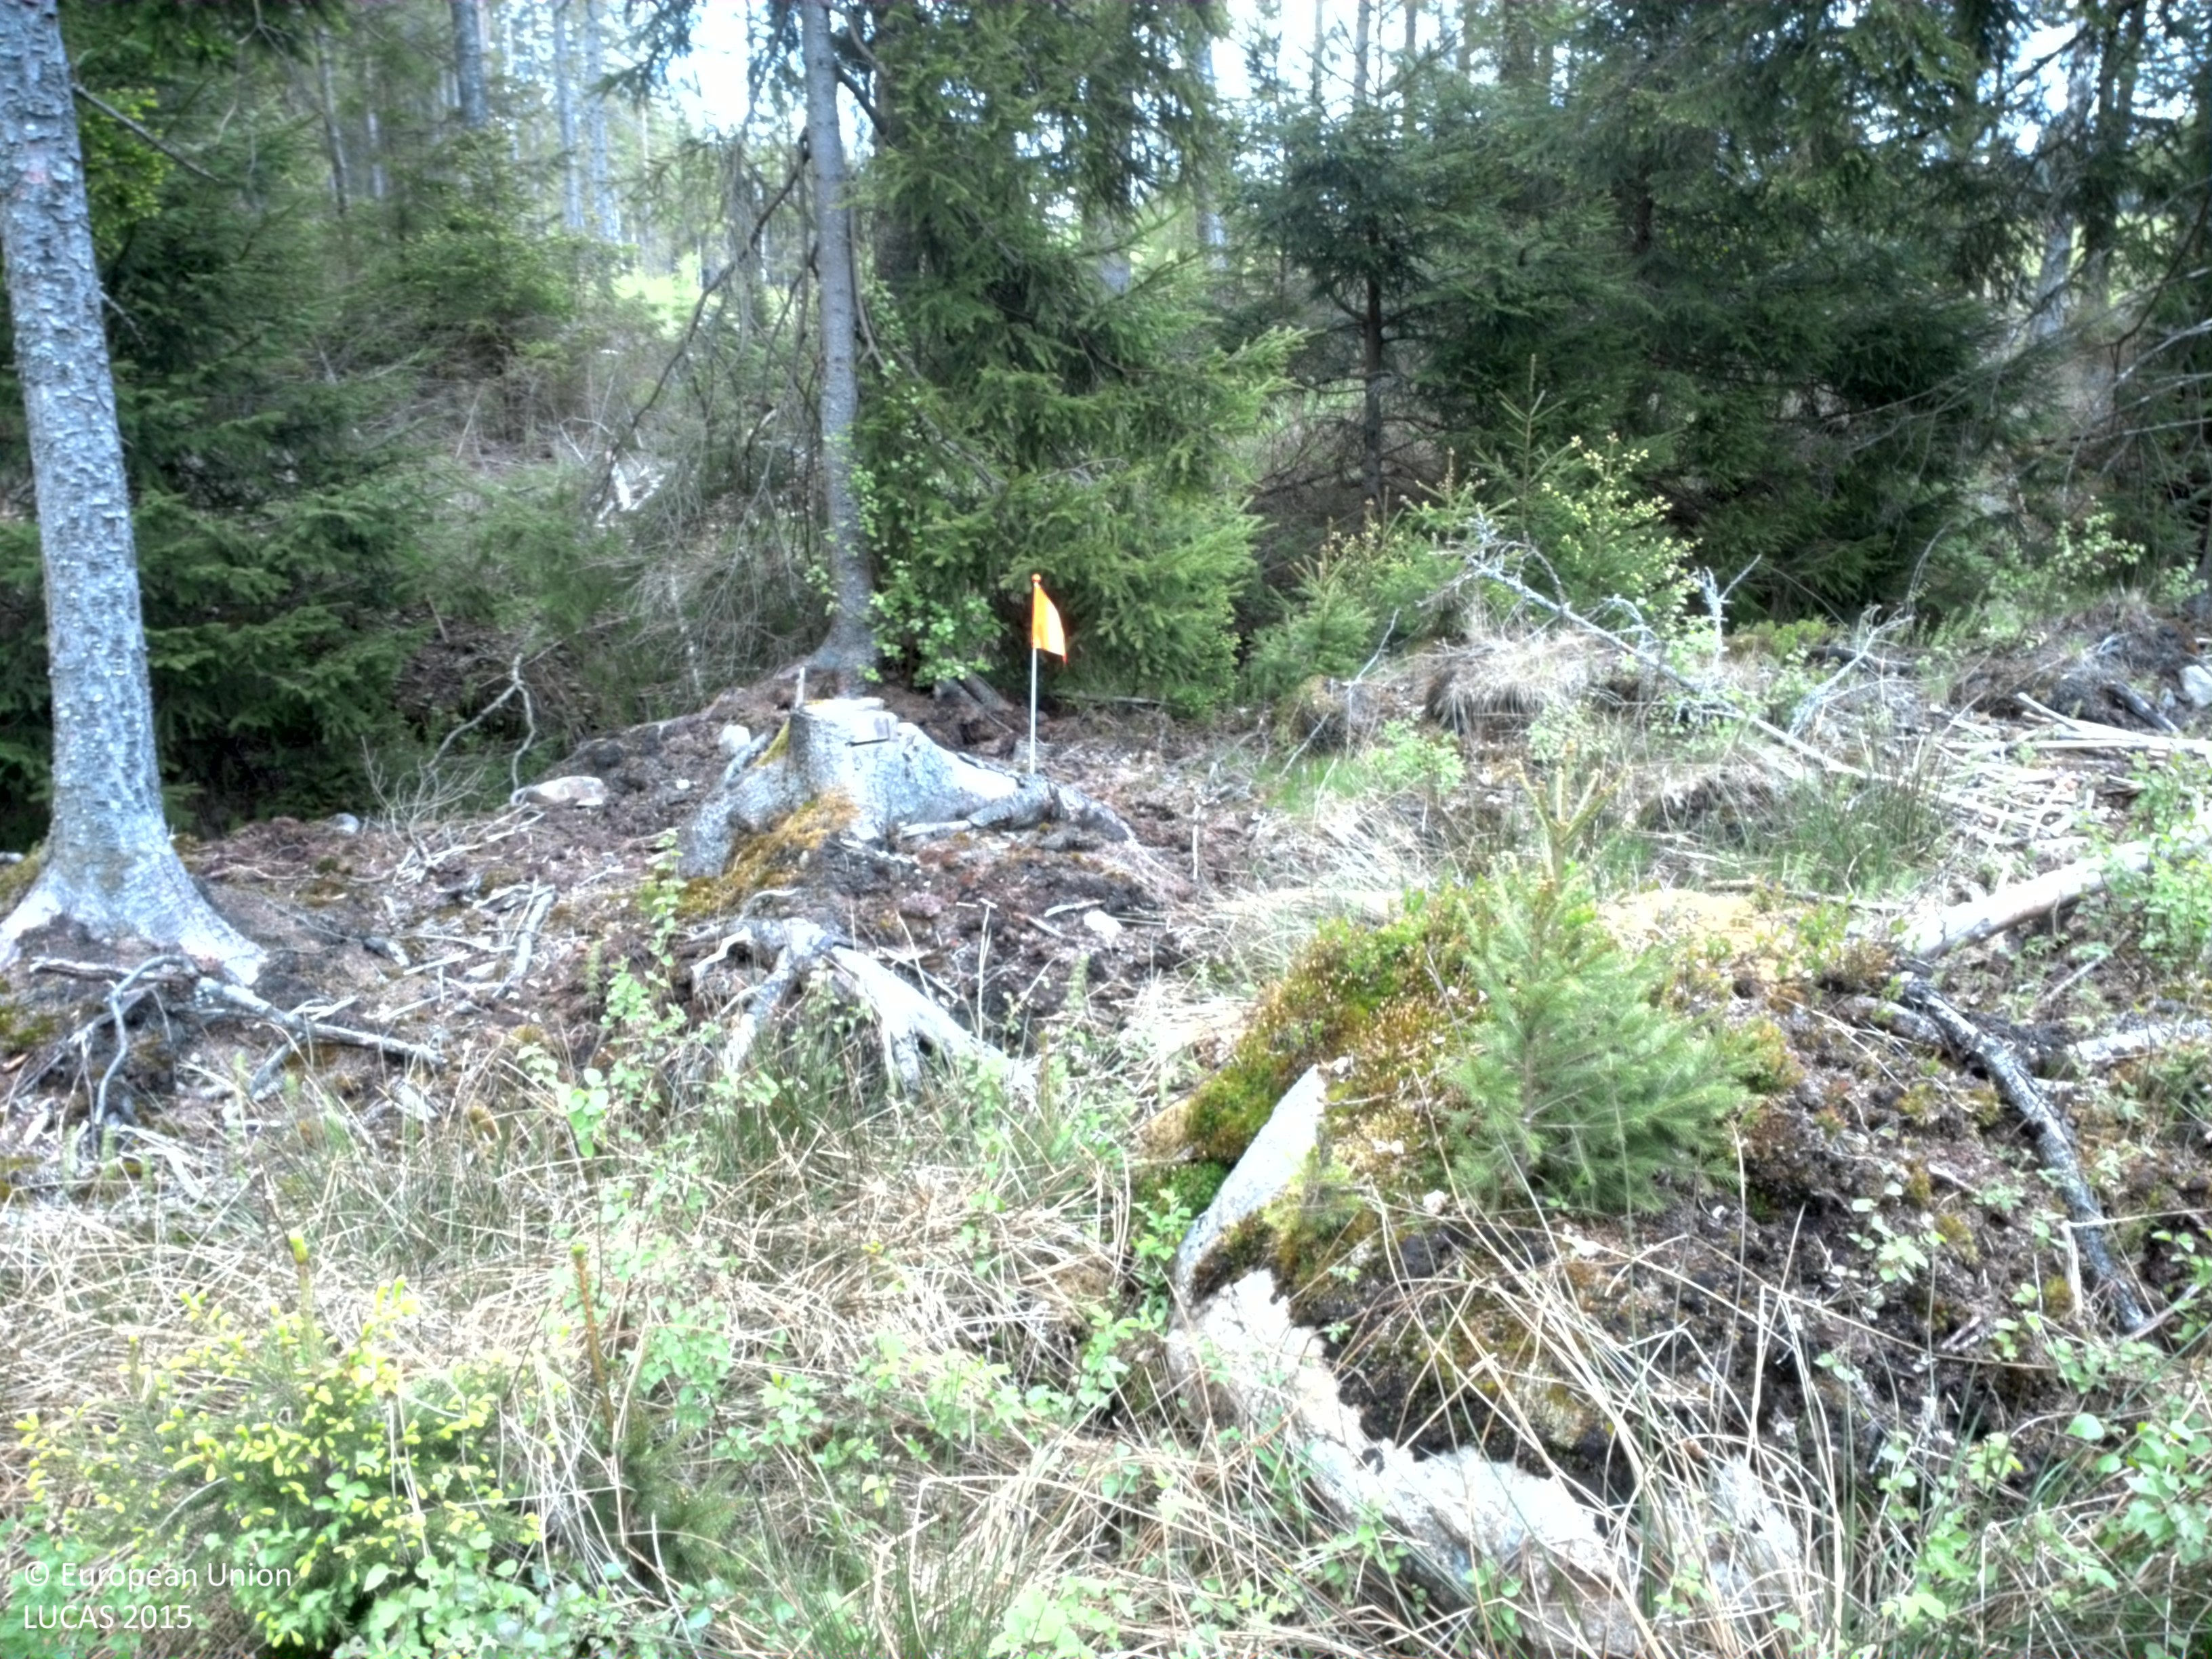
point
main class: Woodland
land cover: Spruce dominated mixed woodland
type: boreal forest
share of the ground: 25 - 50 %
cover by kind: coniferous forest trees 30 %, herbaceous plants 20 %, unconsolidated bare surface 15 %, broadleaved forest trees 10 %, shrubs 10 %, lichens and mosses 10 %, consolidated bare surface 5 %
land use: Forestry
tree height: > 5 m
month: May
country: SE
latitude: 56.6563
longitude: 15.2672
